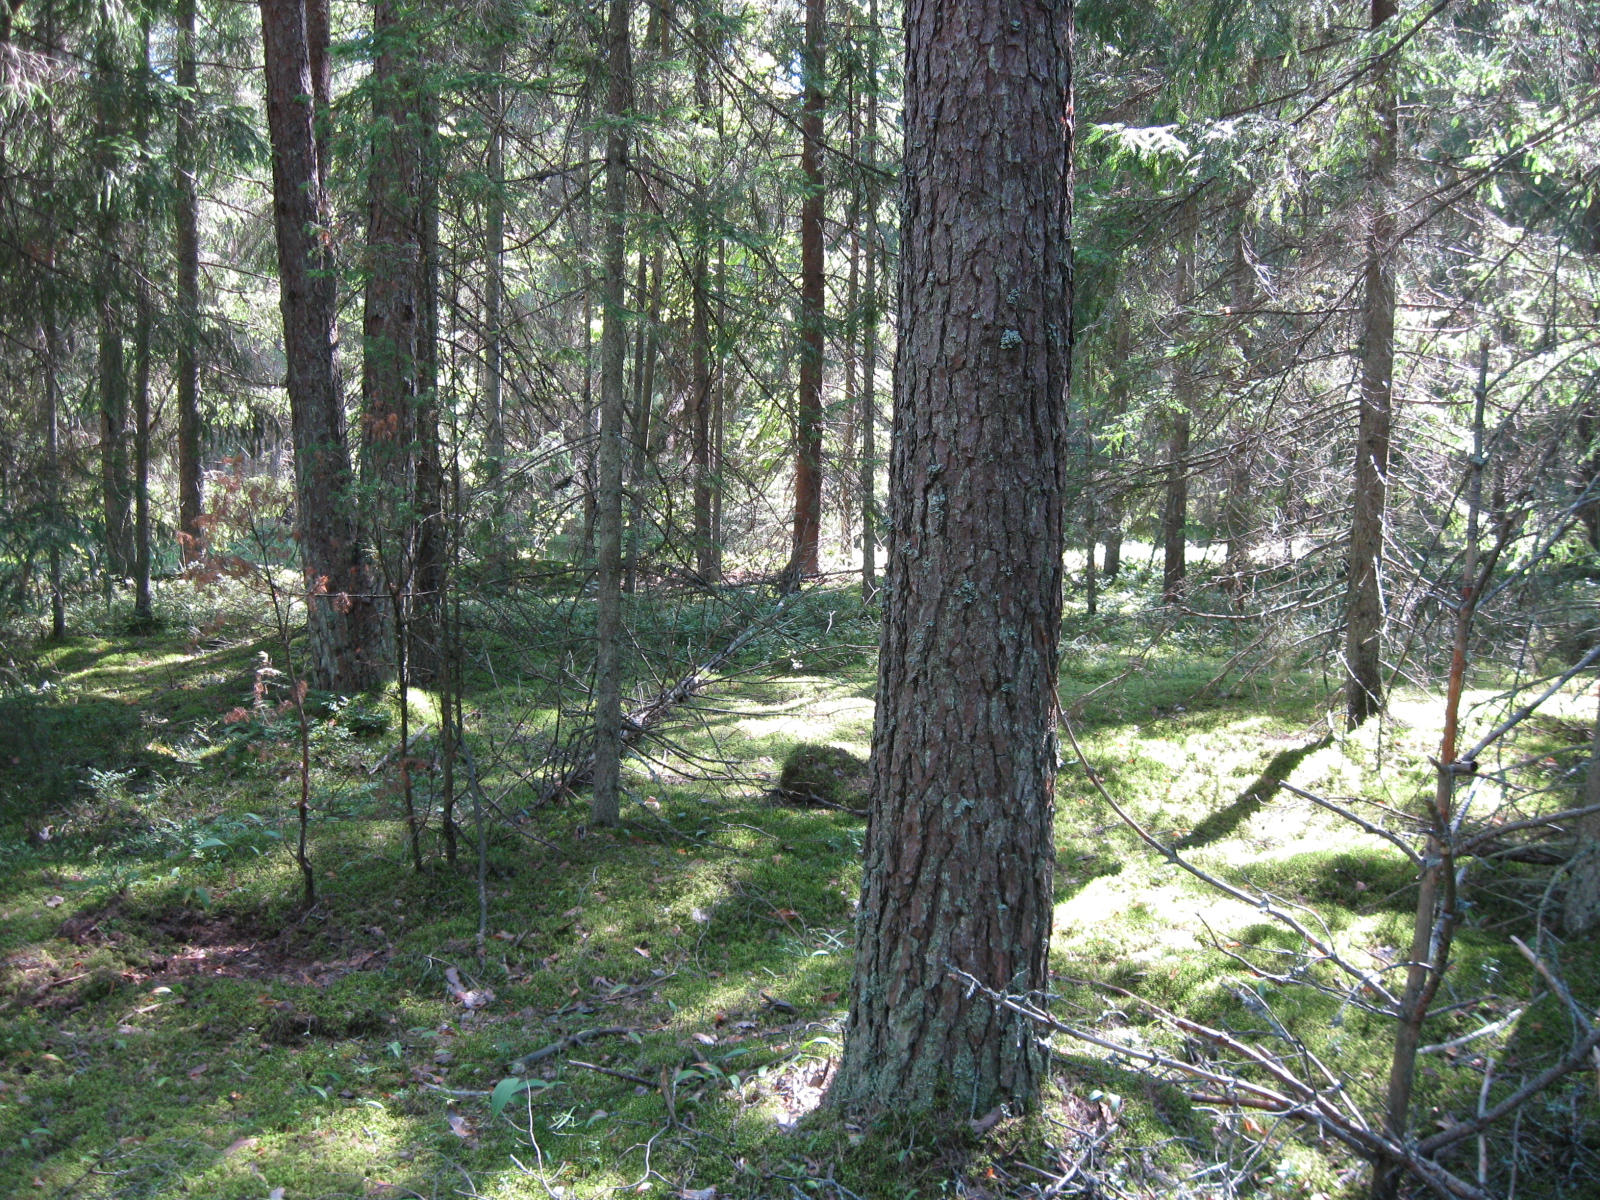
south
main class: Woodland
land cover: Other coniferous woodland
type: hemiboreal forest and nemoral coniferous forest and mixed broadleaved-coniferous forest
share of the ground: > 75 %
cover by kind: coniferous forest trees 85 %, lichens and mosses 10 %, shrubs 5 %
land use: Forestry
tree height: > 5 m
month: August
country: LT
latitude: 54.9416
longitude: 23.4898
